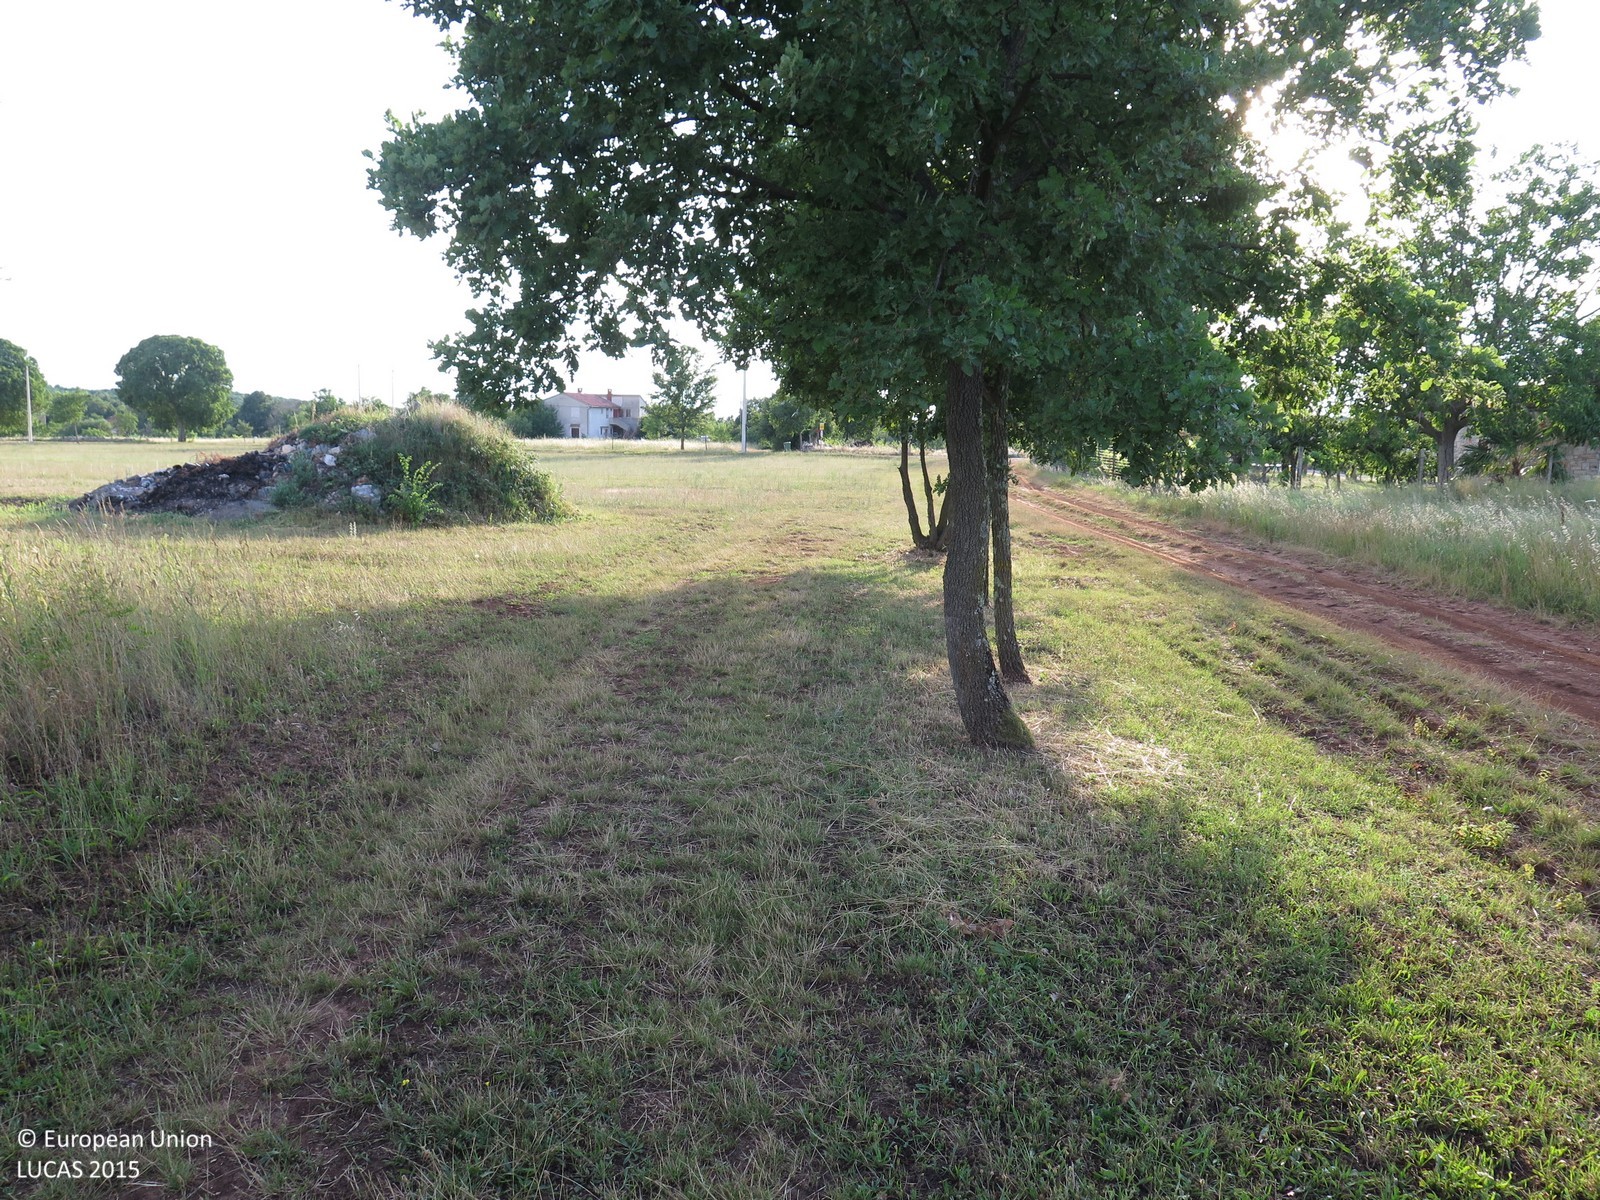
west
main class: Grassland
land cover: Grassland without tree/shrub cover
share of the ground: > 75 %
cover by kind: herbaceous plants 100 %
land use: Agriculture (excluding fallow land and kitchen gardens)
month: June
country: HR
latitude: 45.2069
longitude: 13.6488
